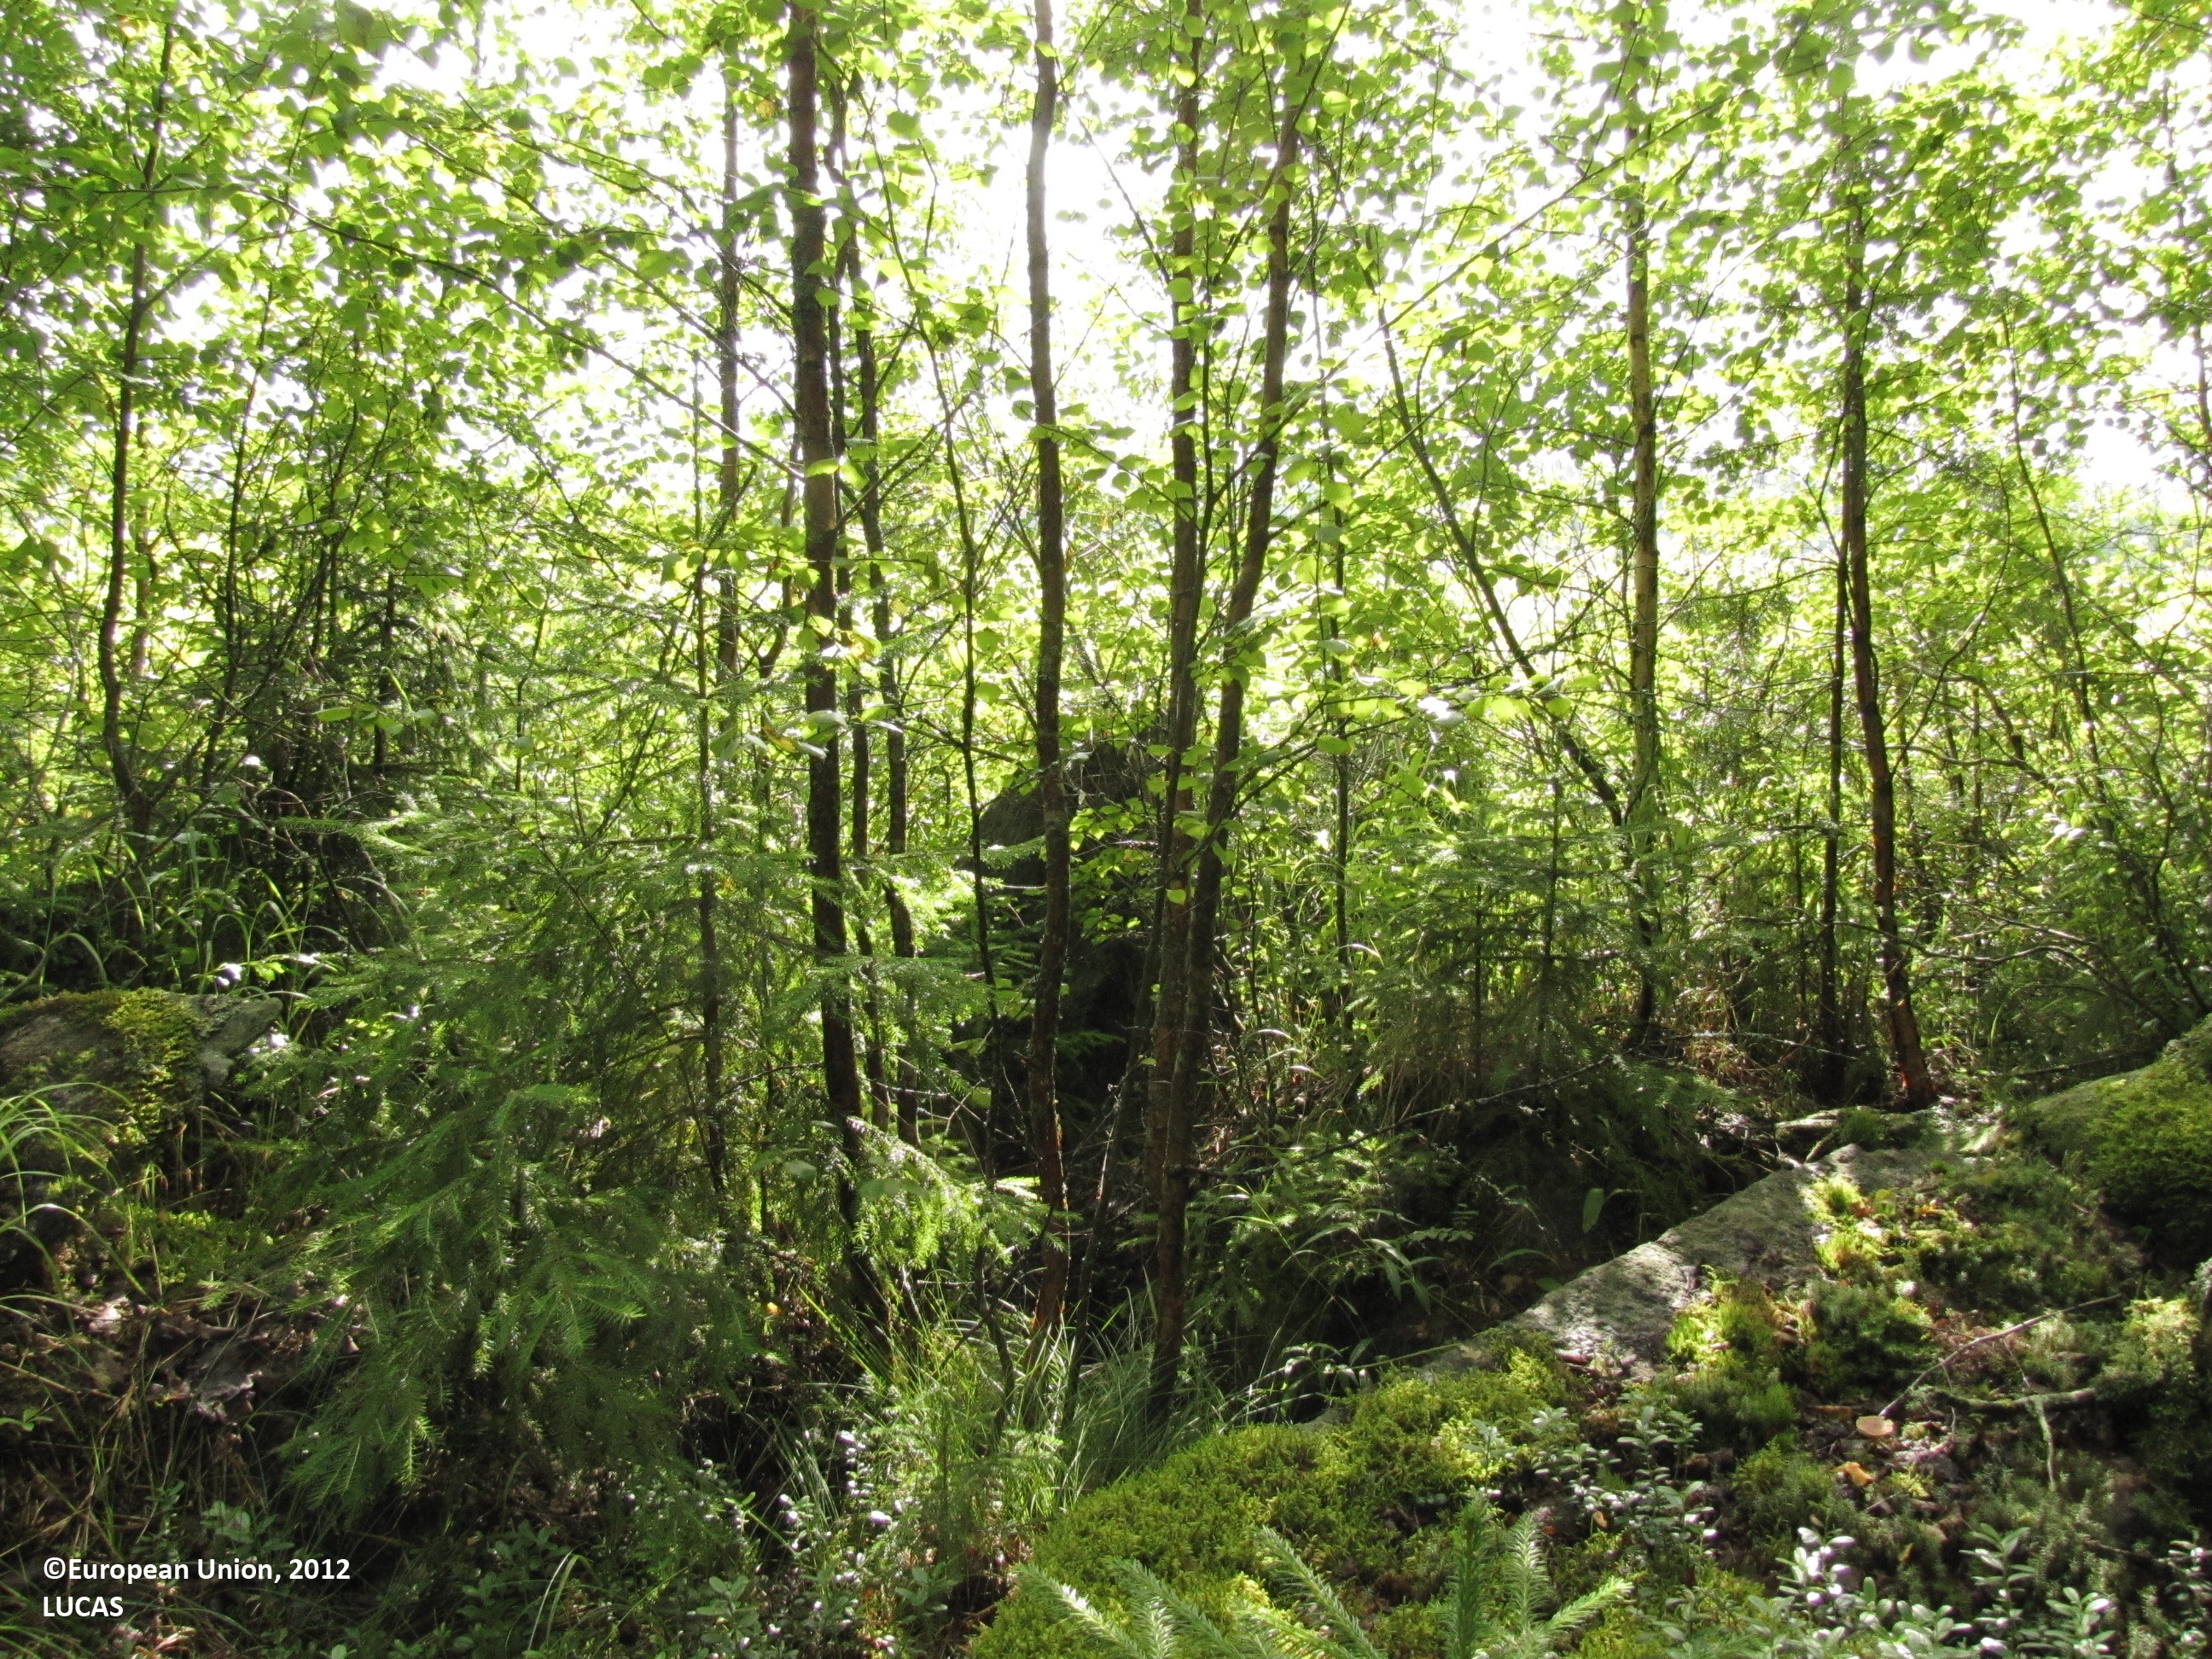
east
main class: Woodland
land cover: Pine dominated mixed woodland
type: boreal forest
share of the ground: 25 - 50 %
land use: Forestry
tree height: > 5 m
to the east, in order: Pine dominated mixed woodland; Abandoned hedges; Ditches and canals; Abandoned hedges; Temporary grasslands
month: July
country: FI
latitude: 62.2036
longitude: 23.0801
